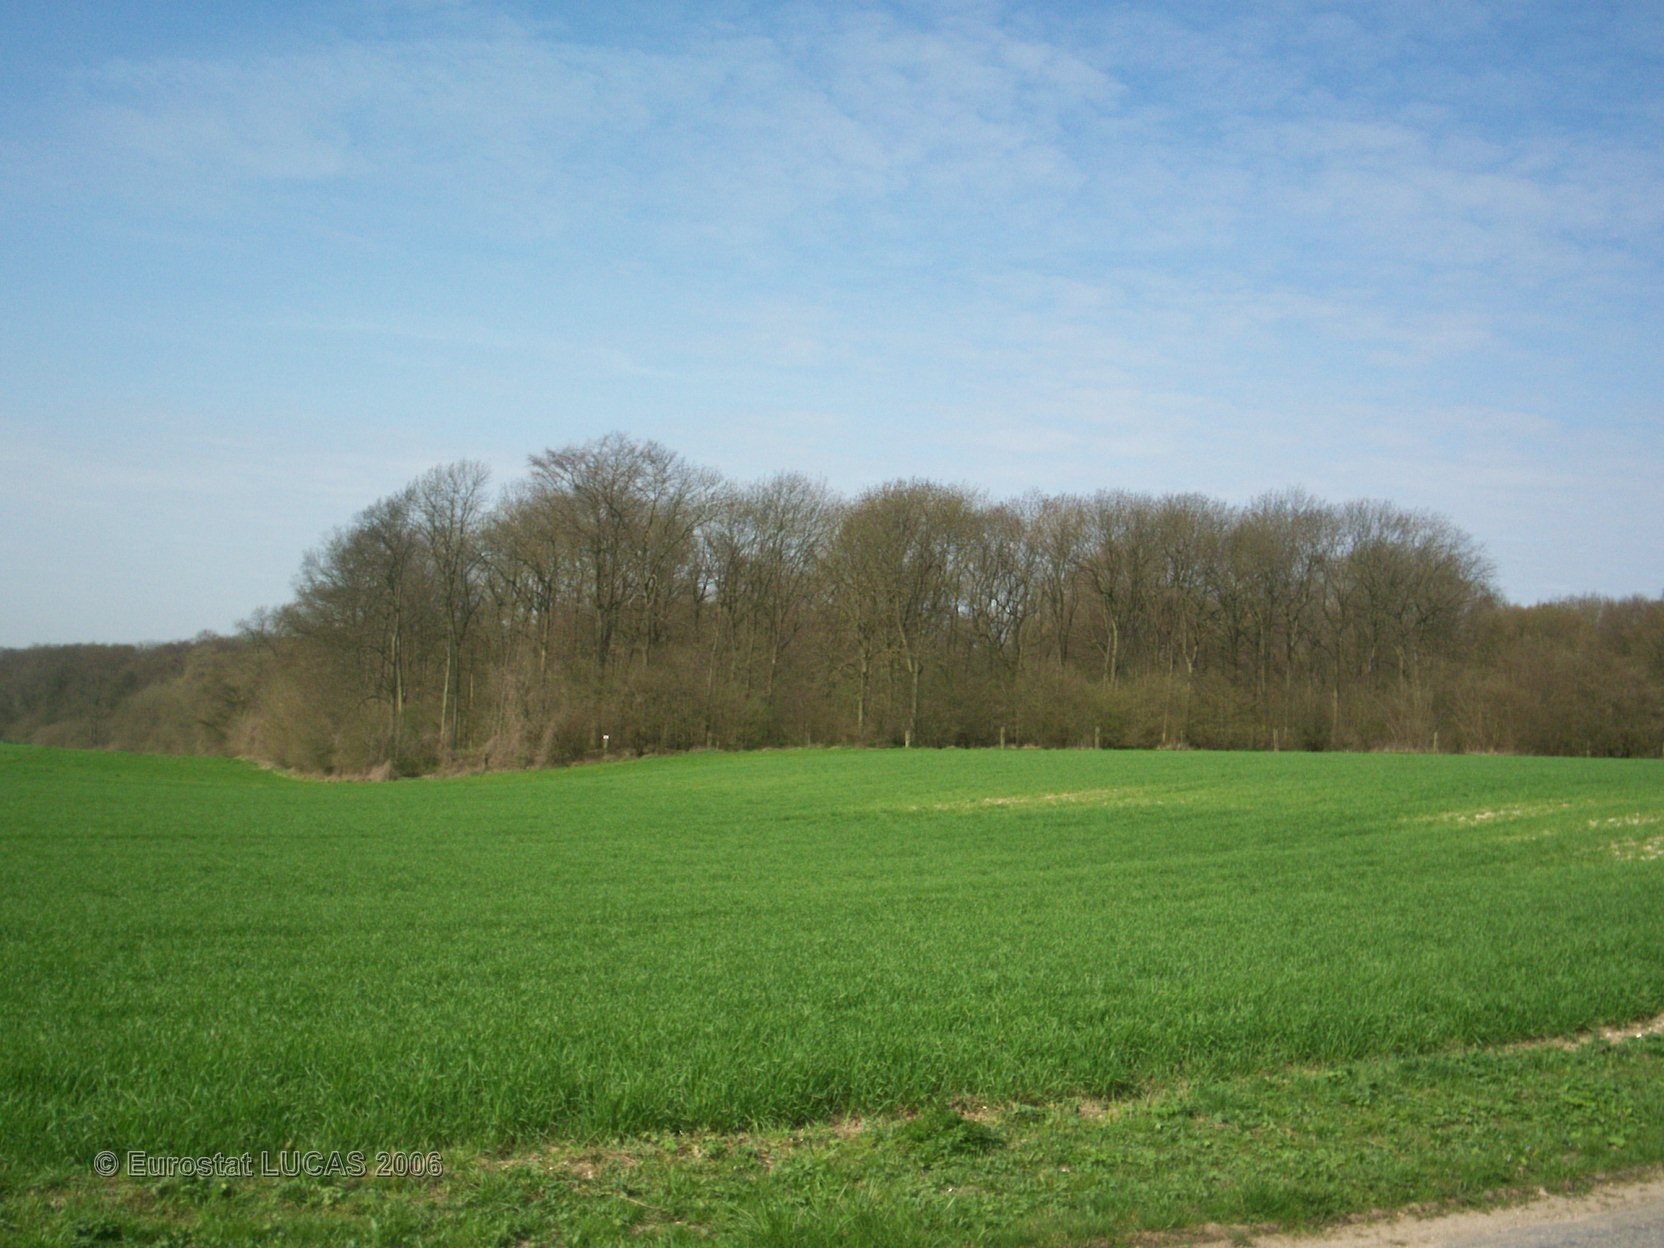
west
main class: Cropland
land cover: Common wheat
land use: Agriculture (excluding fallow land and kitchen gardens)
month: April
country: FR
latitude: 50.0574
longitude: 2.6834
